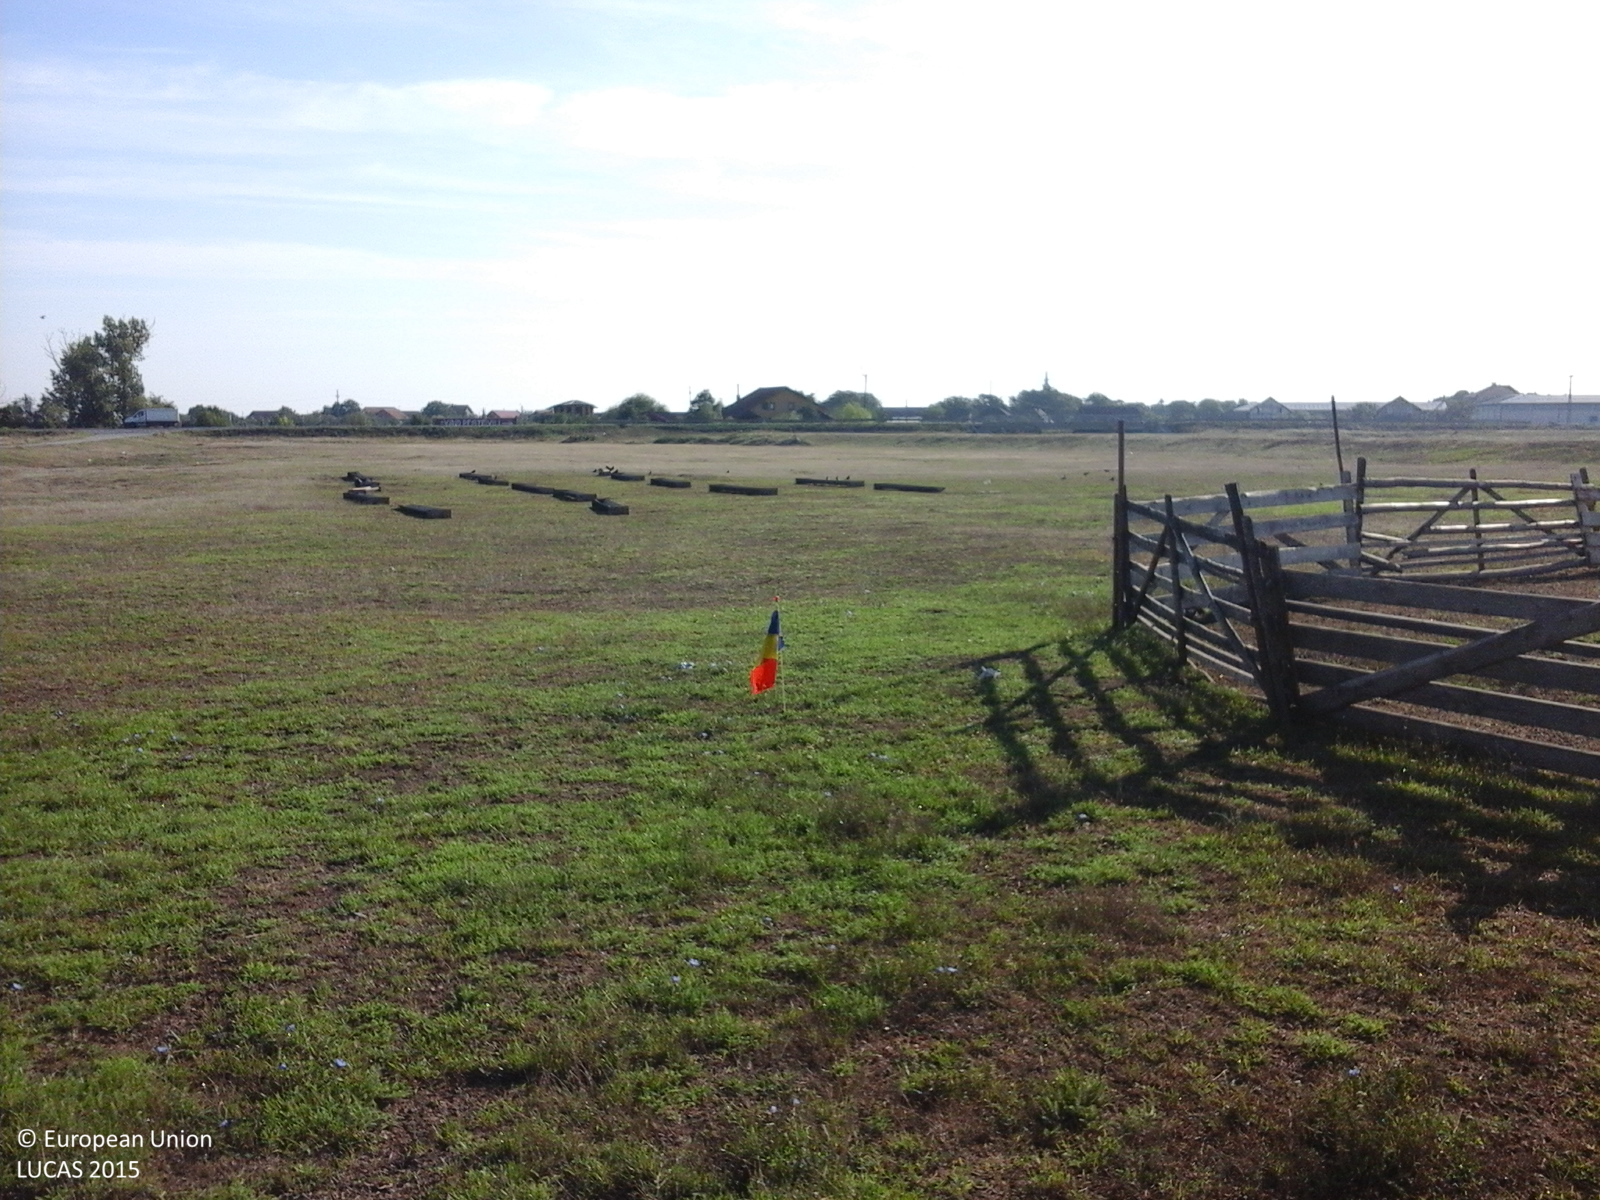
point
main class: Grassland
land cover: Grassland without tree/shrub cover
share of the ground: > 75 %
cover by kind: herbaceous plants 100 %
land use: Agriculture (excluding fallow land and kitchen gardens)
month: August
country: RO
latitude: 45.8328
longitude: 21.0359
